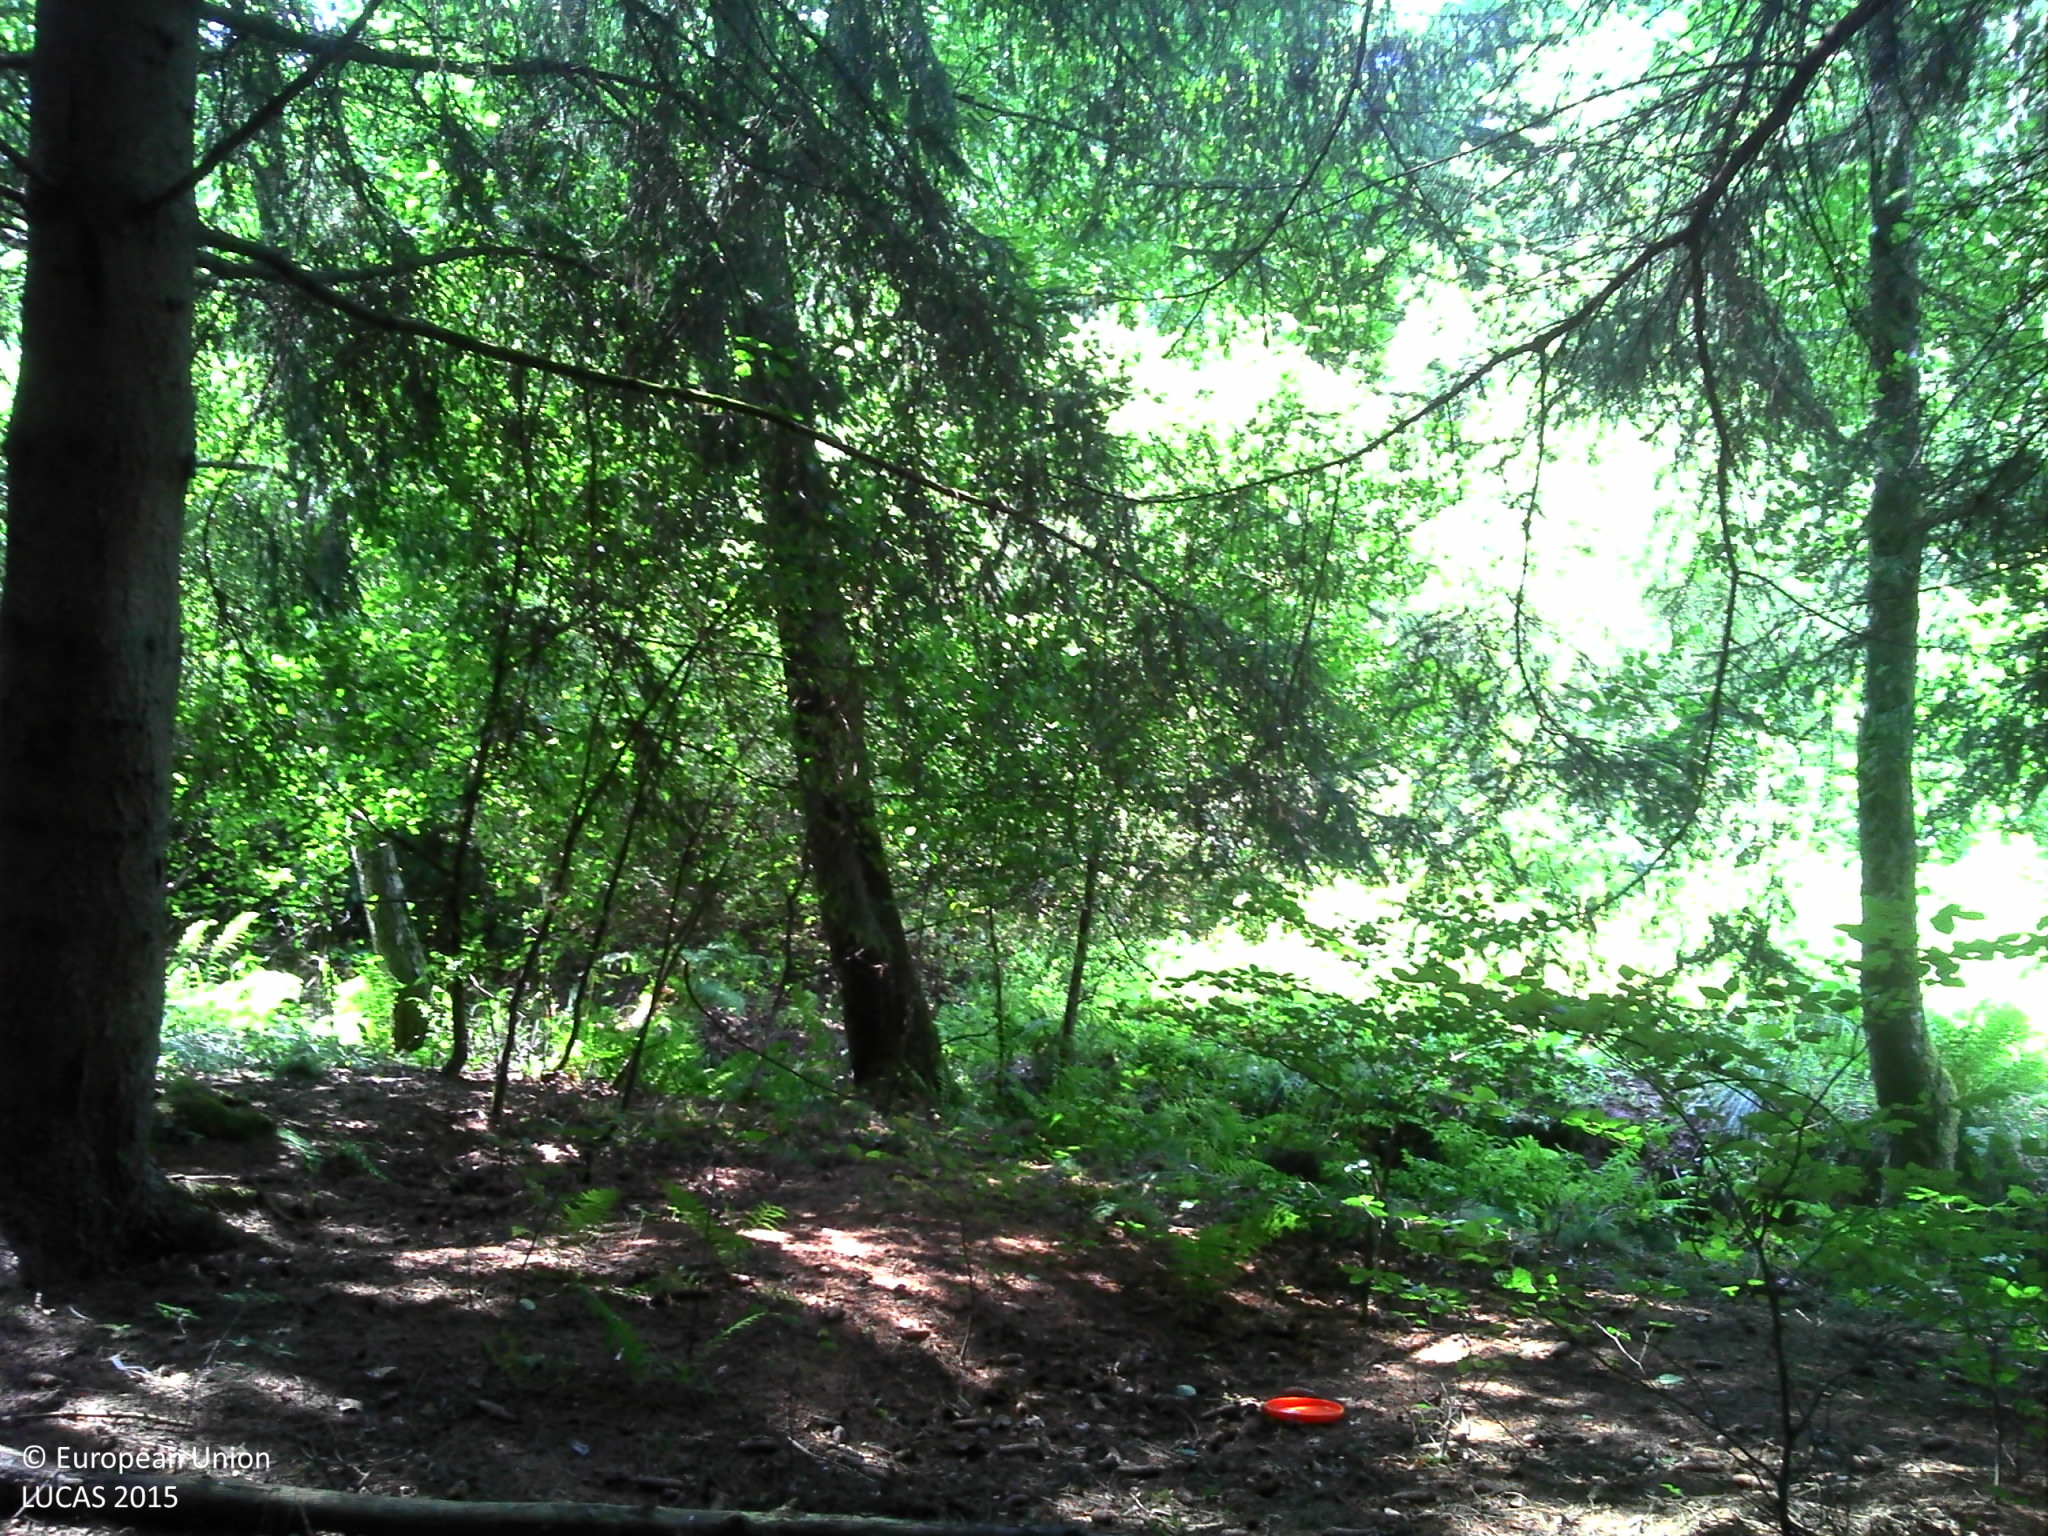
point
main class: Woodland
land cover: Spruce dominated mixed woodland
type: hemiboreal forest and nemoral coniferous forest and mixed broadleaved-coniferous forest
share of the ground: > 75 %
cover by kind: coniferous forest trees 70 %, broadleaved forest trees 30 %
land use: Forestry
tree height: > 5 m
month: August
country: FR
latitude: 48.9122
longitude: 7.3672
